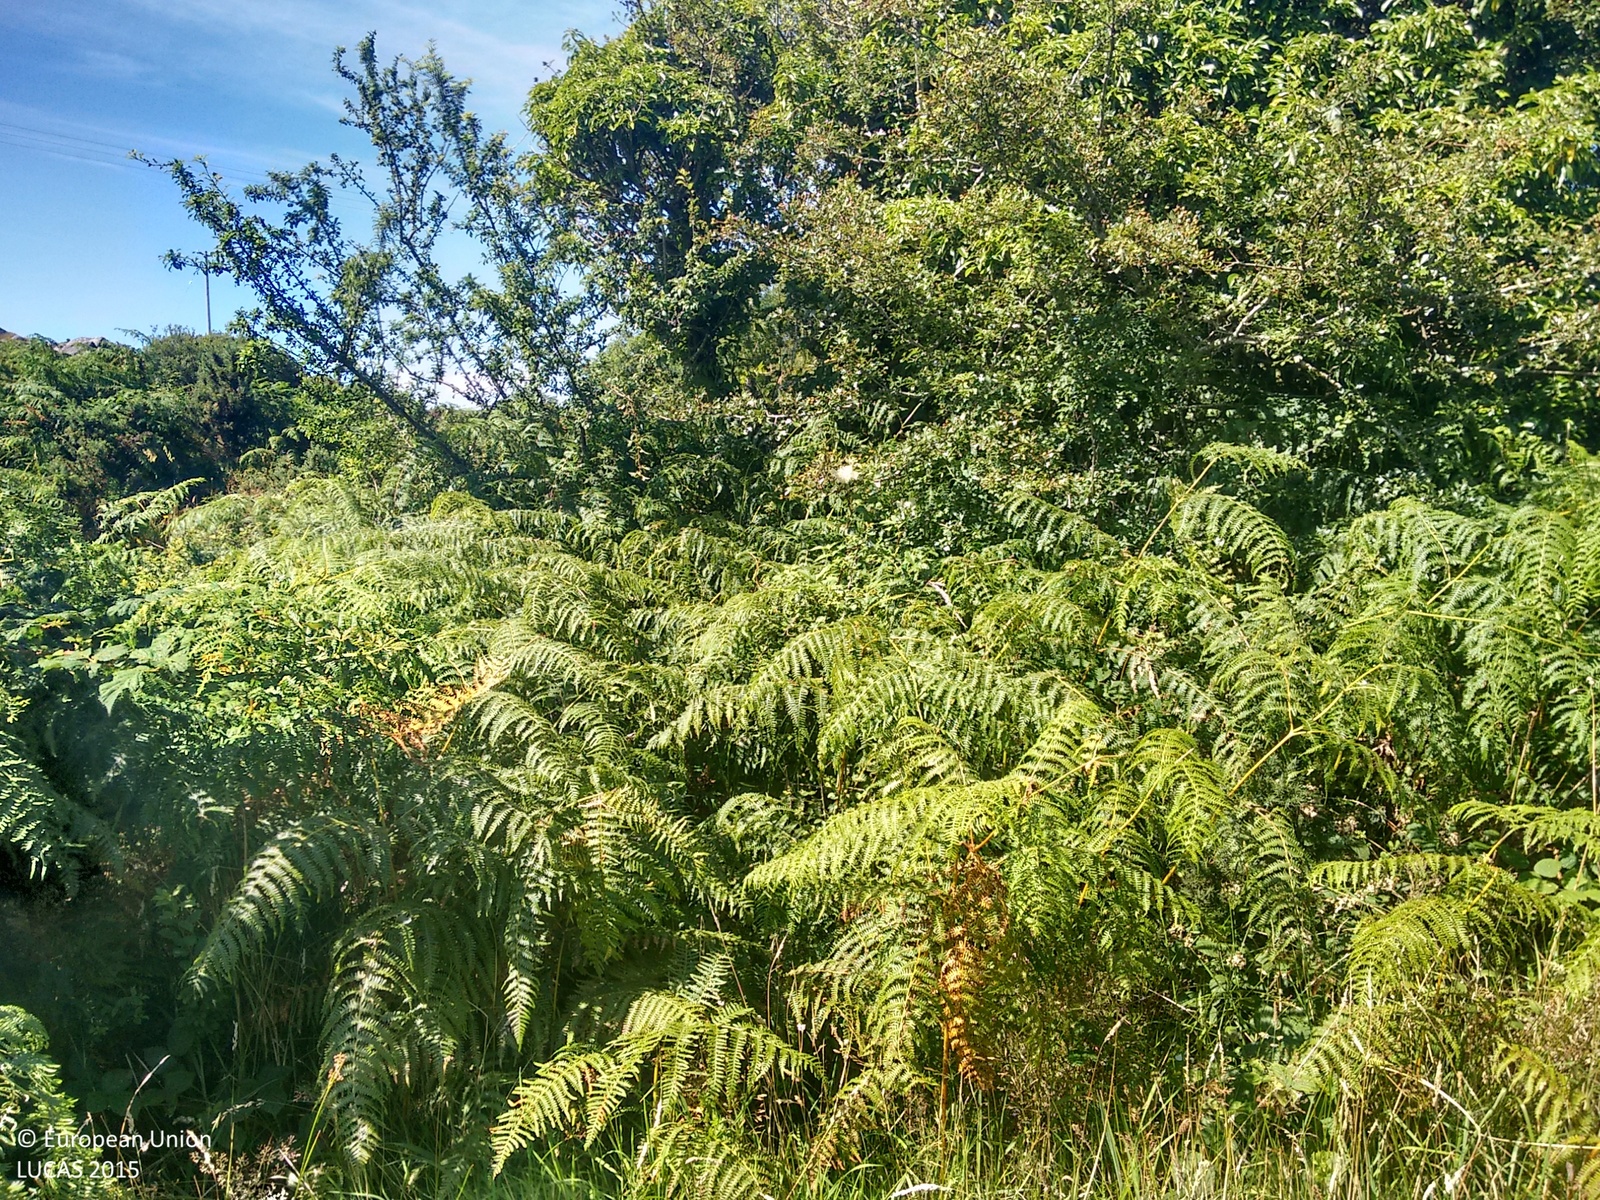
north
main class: Shrubland
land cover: Shrubland with sparse tree cover
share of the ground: > 75 %
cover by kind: shrubs 65 %, herbaceous plants 30 %, broadleaved forest trees 5 %
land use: Agriculture (excluding fallow land and kitchen gardens)
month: August
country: IE
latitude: 51.5759
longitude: -9.4659
